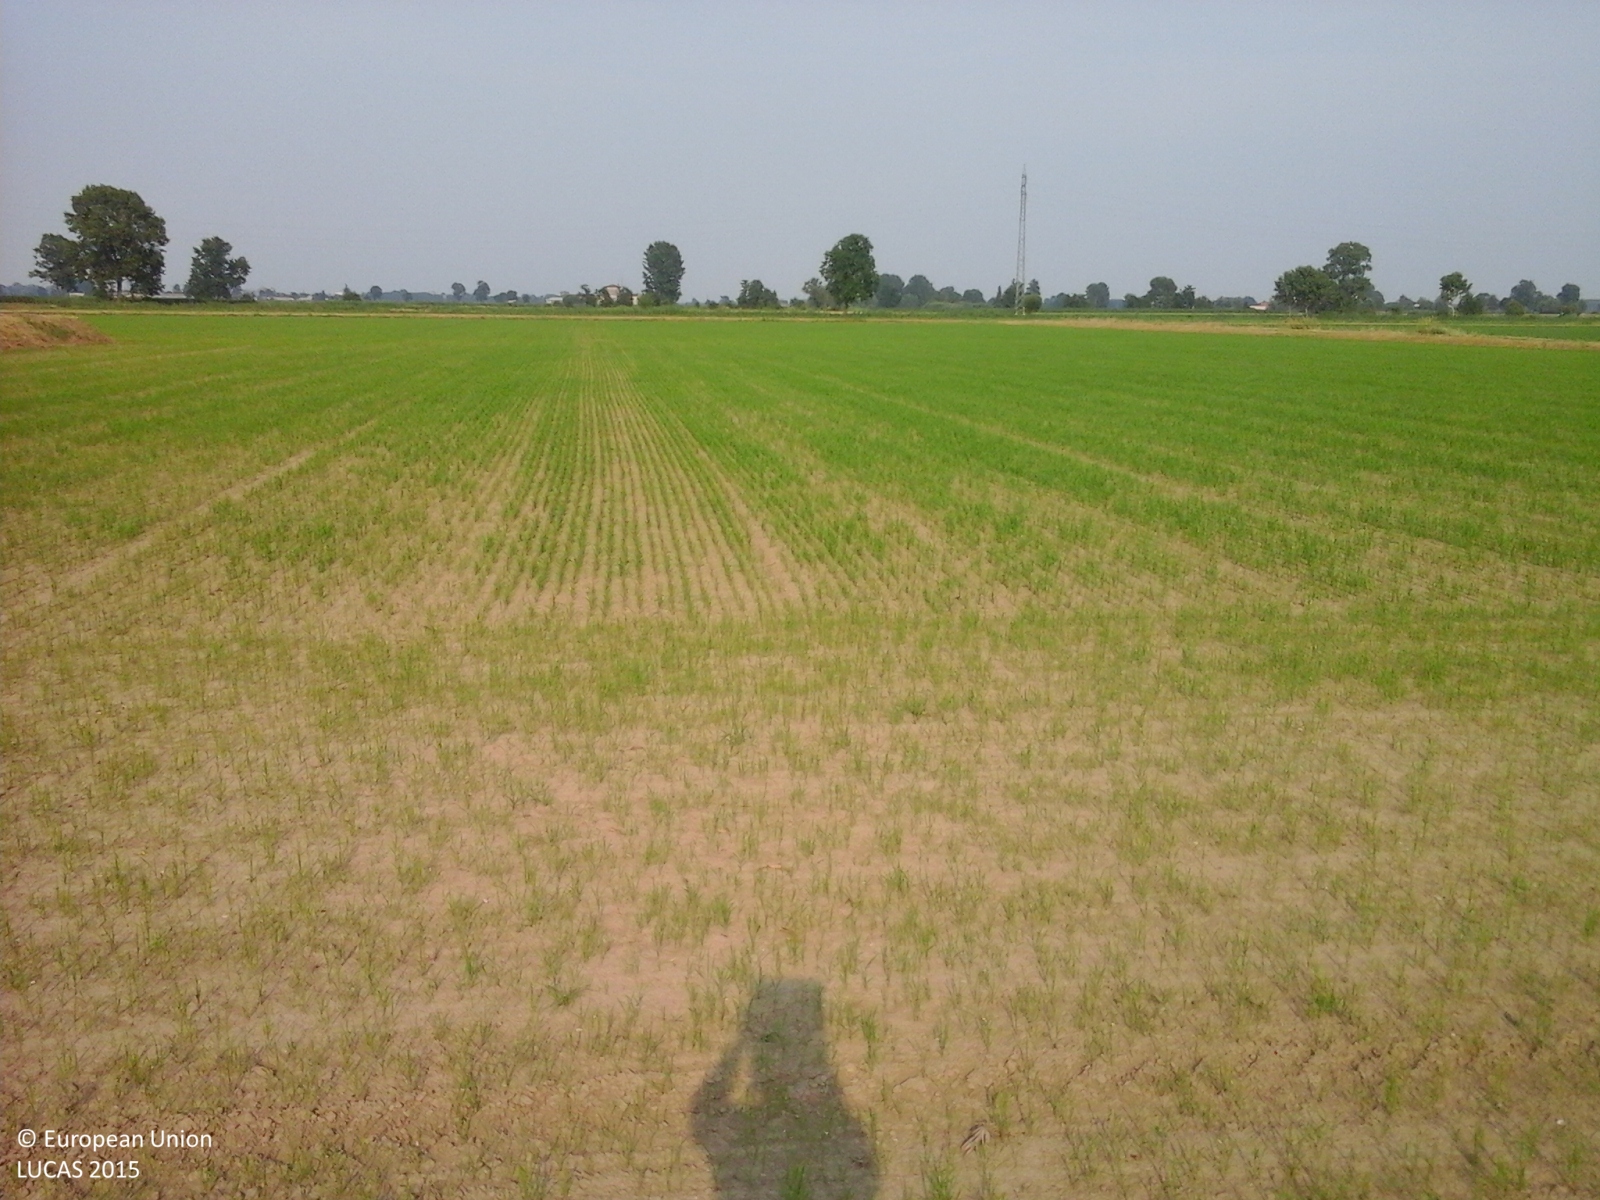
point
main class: Cropland
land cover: Rice
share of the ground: 50 - 75 %
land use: Agriculture (excluding fallow land and kitchen gardens)
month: June
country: IT
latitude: 45.1240
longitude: 9.3782
